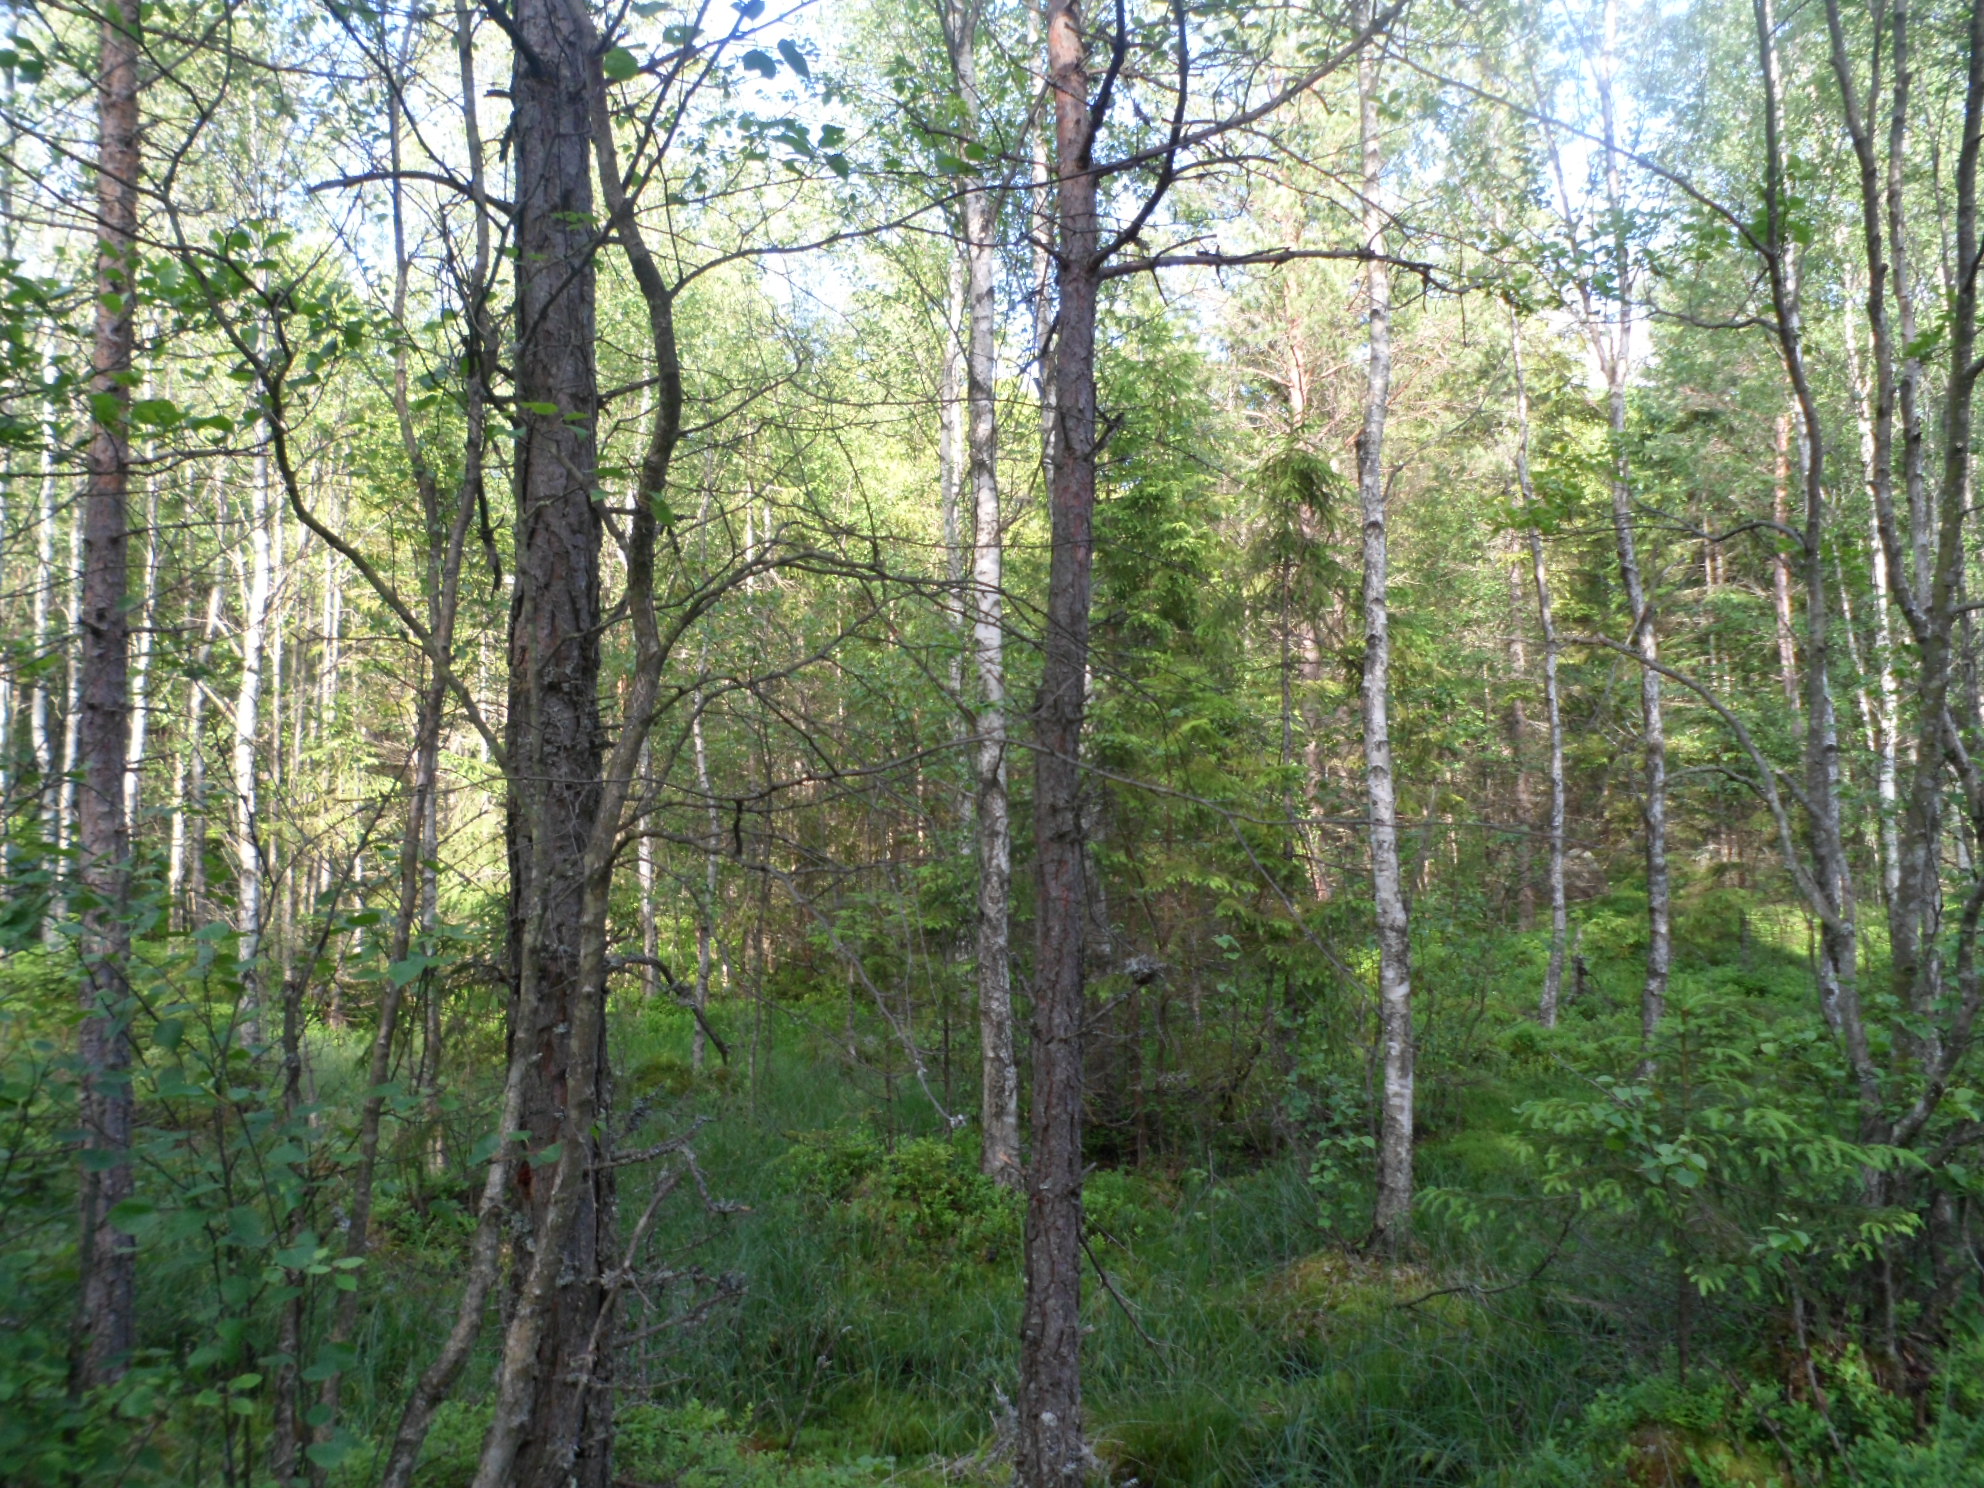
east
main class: Woodland
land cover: Pine dominated mixed woodland
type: boreal forest
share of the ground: 25 - 50 %
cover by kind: lichens and mosses 30 %, coniferous forest trees 25 %, broadleaved forest trees 25 %, shrubs 10 %, herbaceous plants 10 %
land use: Forestry
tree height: > 5 m
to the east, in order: Pine dominated mixed woodland; Spruce dominated coniferous woodland; Tracks; Spruce dominated coniferous woodland
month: June
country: SE
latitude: 57.1494
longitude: 15.1044
